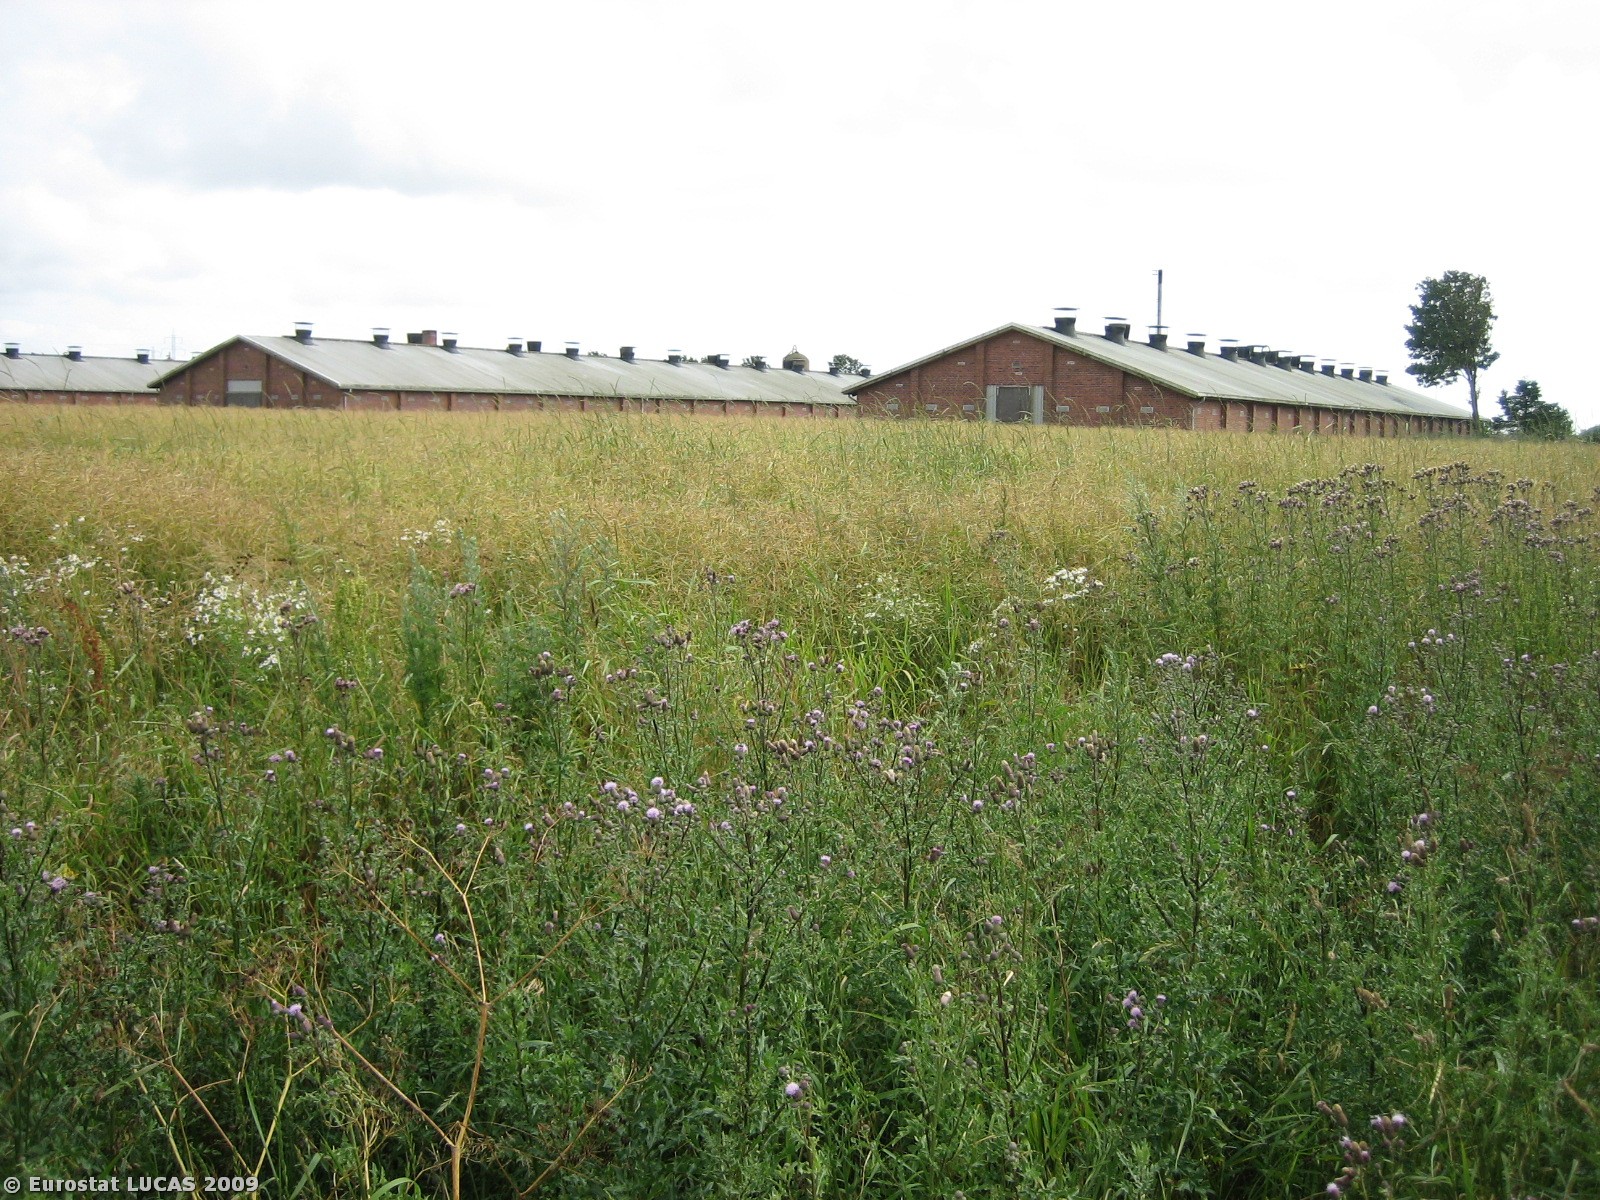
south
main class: Cropland
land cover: Rape and turnip rape
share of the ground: > 75 %
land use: Agriculture (excluding fallow land and kitchen gardens)
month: July
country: DK
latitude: 55.5138
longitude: 8.4969
